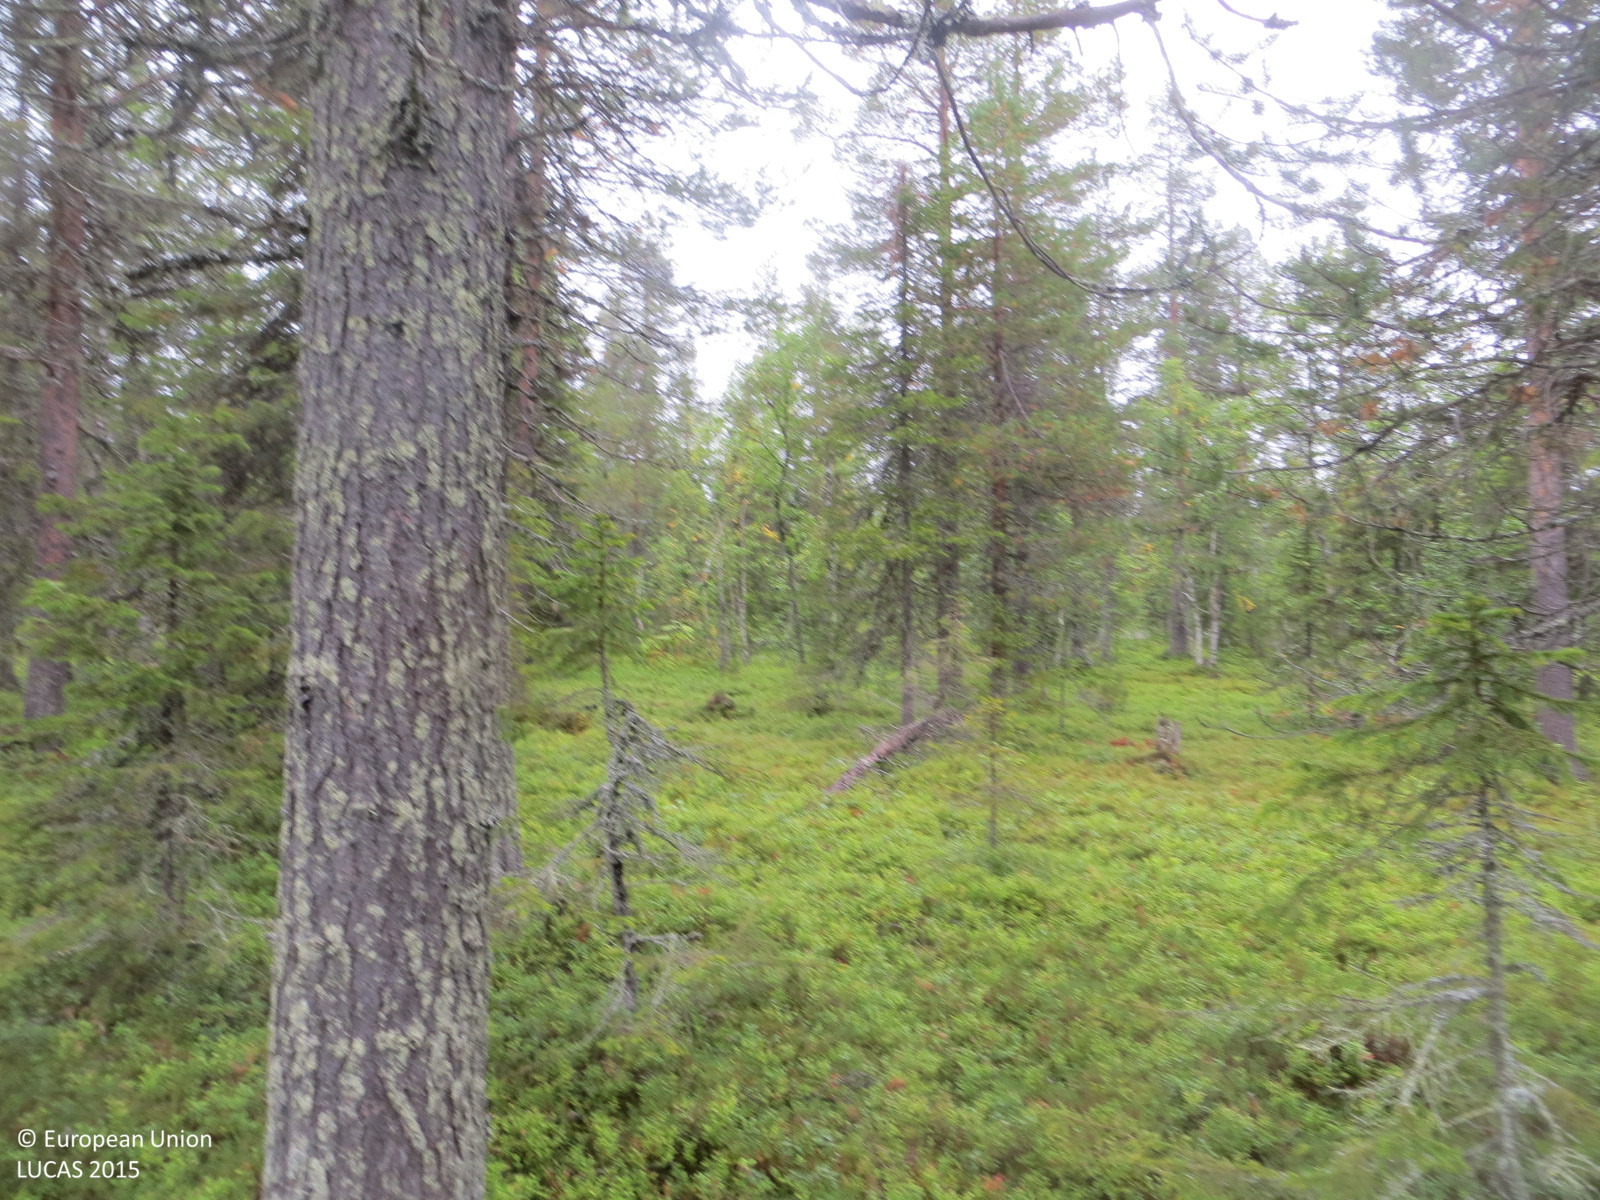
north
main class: Woodland
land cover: Pine dominated coniferous woodland
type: boreal forest
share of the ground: 50 - 75 %
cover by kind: coniferous forest trees 50 %, shrubs 40 %, broadleaved forest trees 10 %
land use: Forestry
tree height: > 5 m
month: August
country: FI
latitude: 67.6363
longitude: 24.8007
